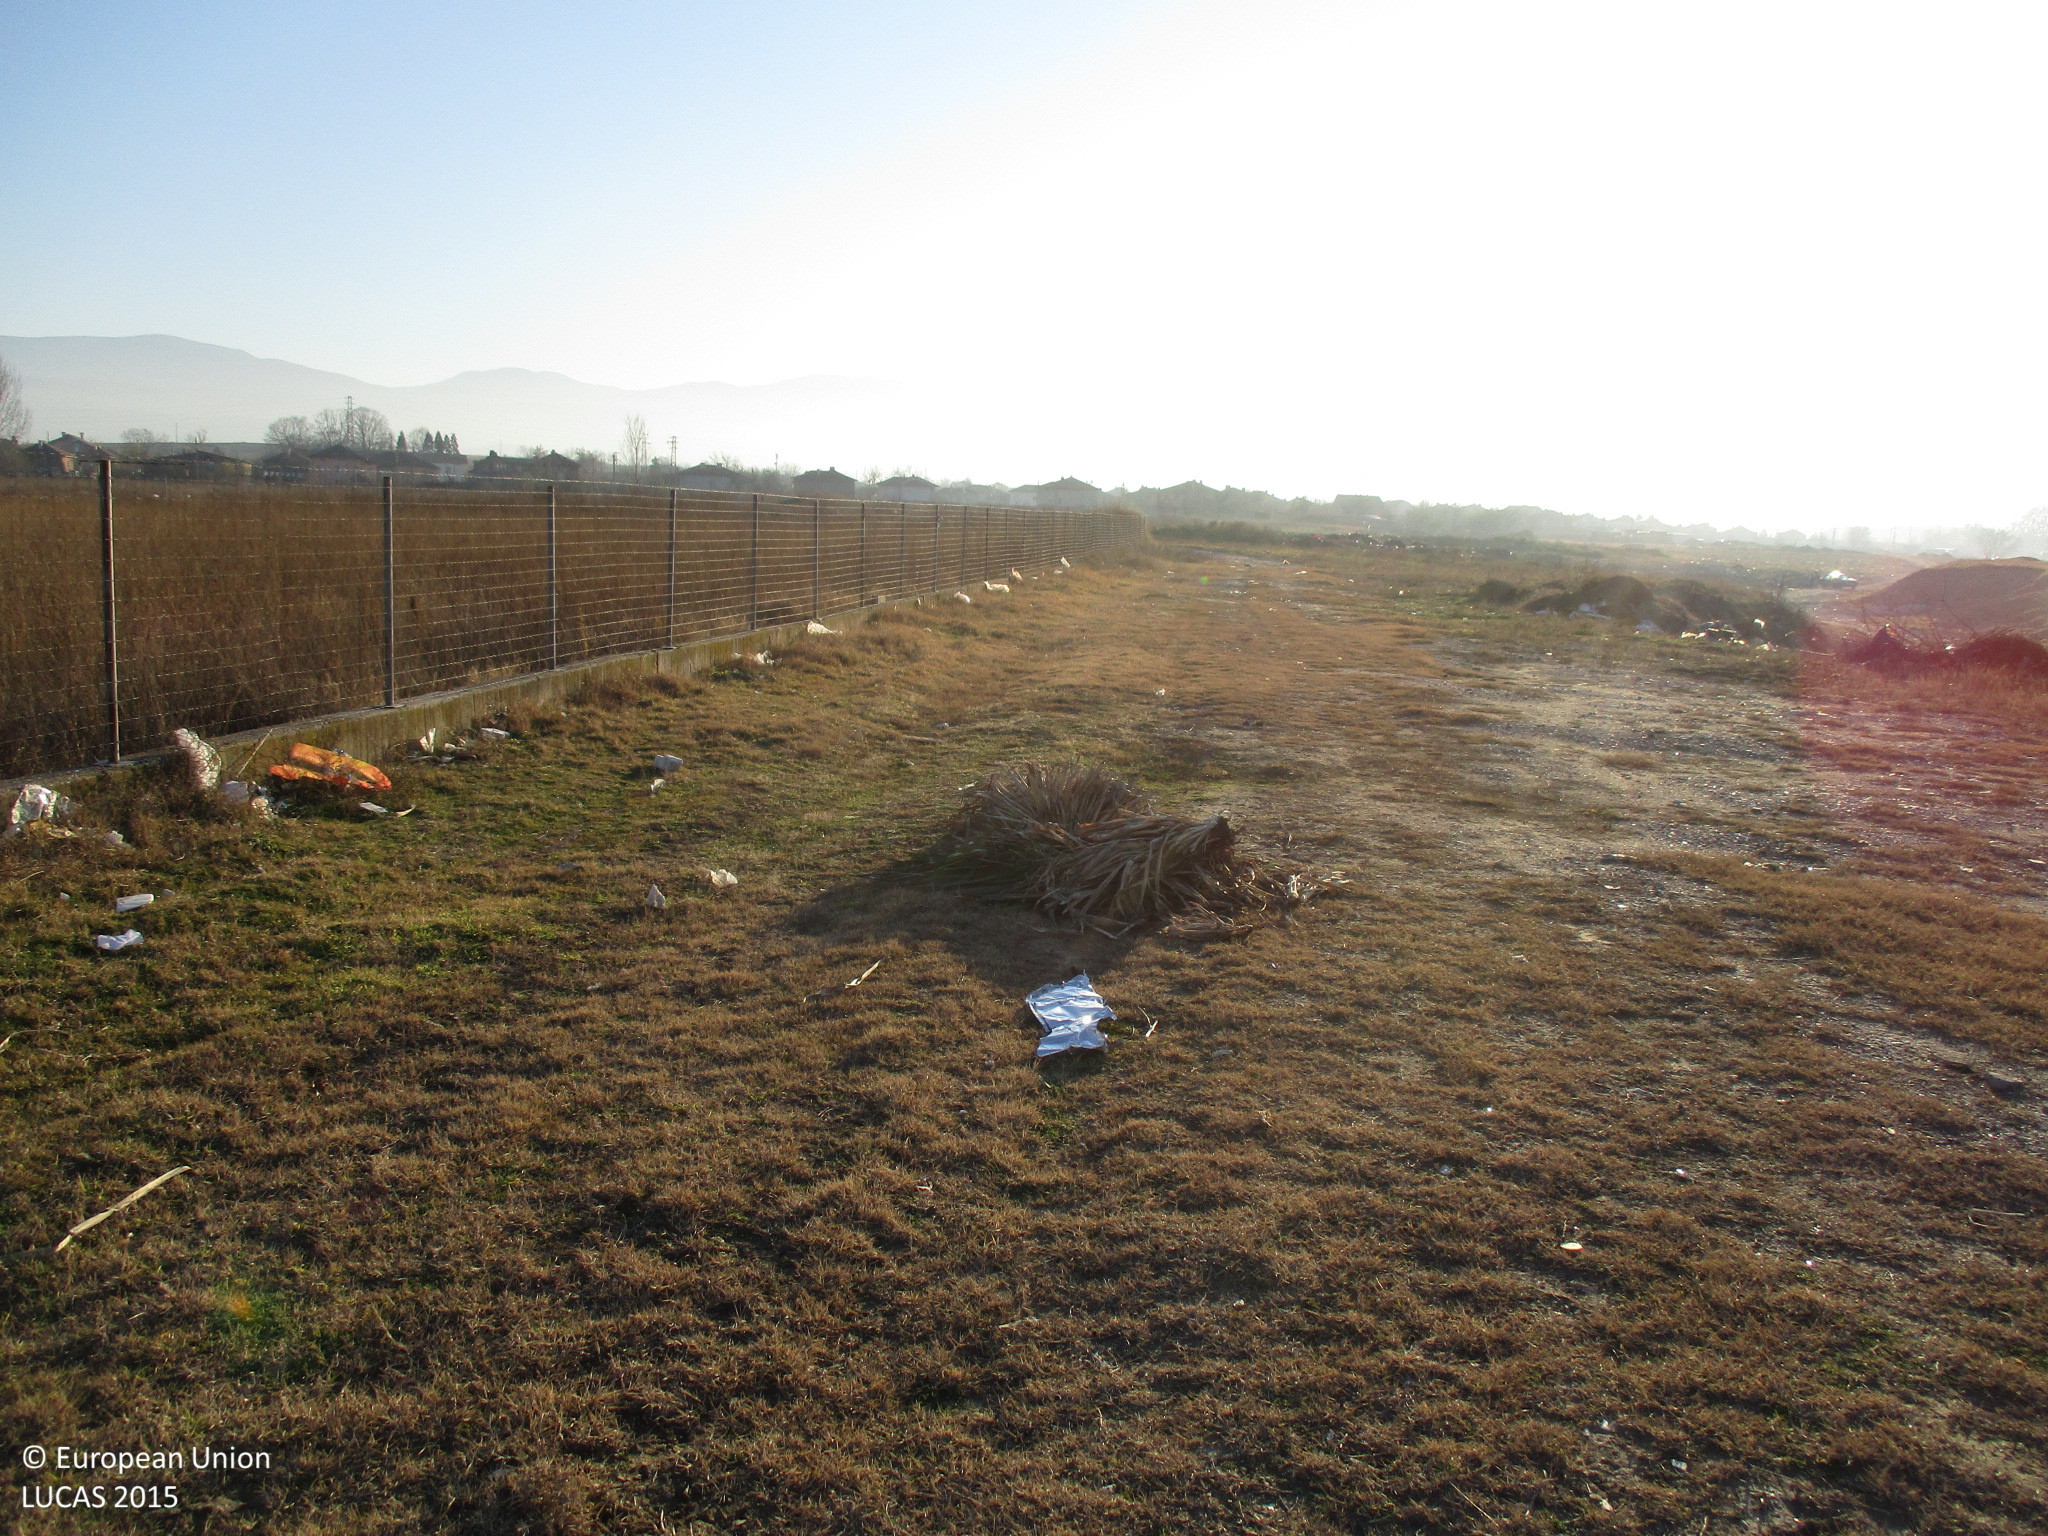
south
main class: Grassland
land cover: Grassland without tree/shrub cover
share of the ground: > 75 %
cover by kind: herbaceous plants 100 %
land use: Agriculture (excluding fallow land and kitchen gardens)
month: December
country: BG
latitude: 42.1387
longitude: 24.6040
